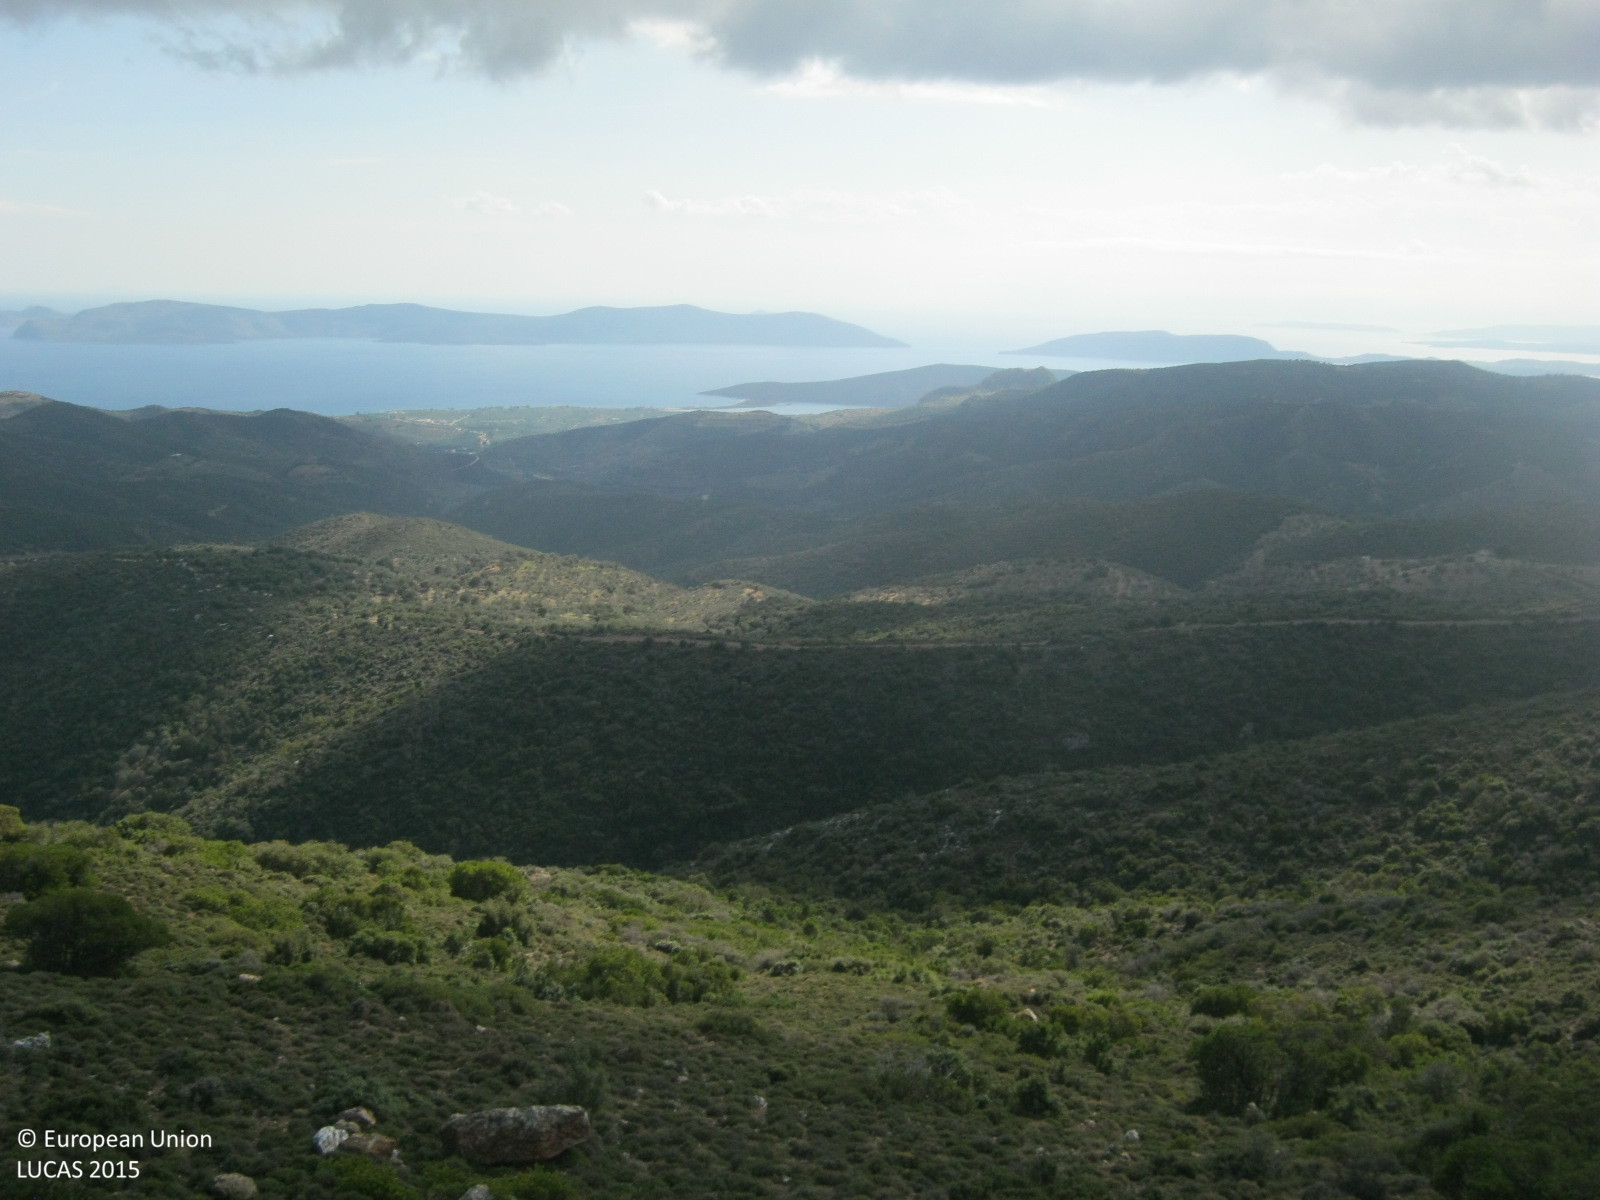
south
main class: Shrubland
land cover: Shrubland without tree cover
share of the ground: > 75 %
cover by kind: shrubs 90 %, unconsolidated bare surface 10 %
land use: Semi-natural and natural areas not in use
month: October
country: GR
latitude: 37.4664
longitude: 23.3216
